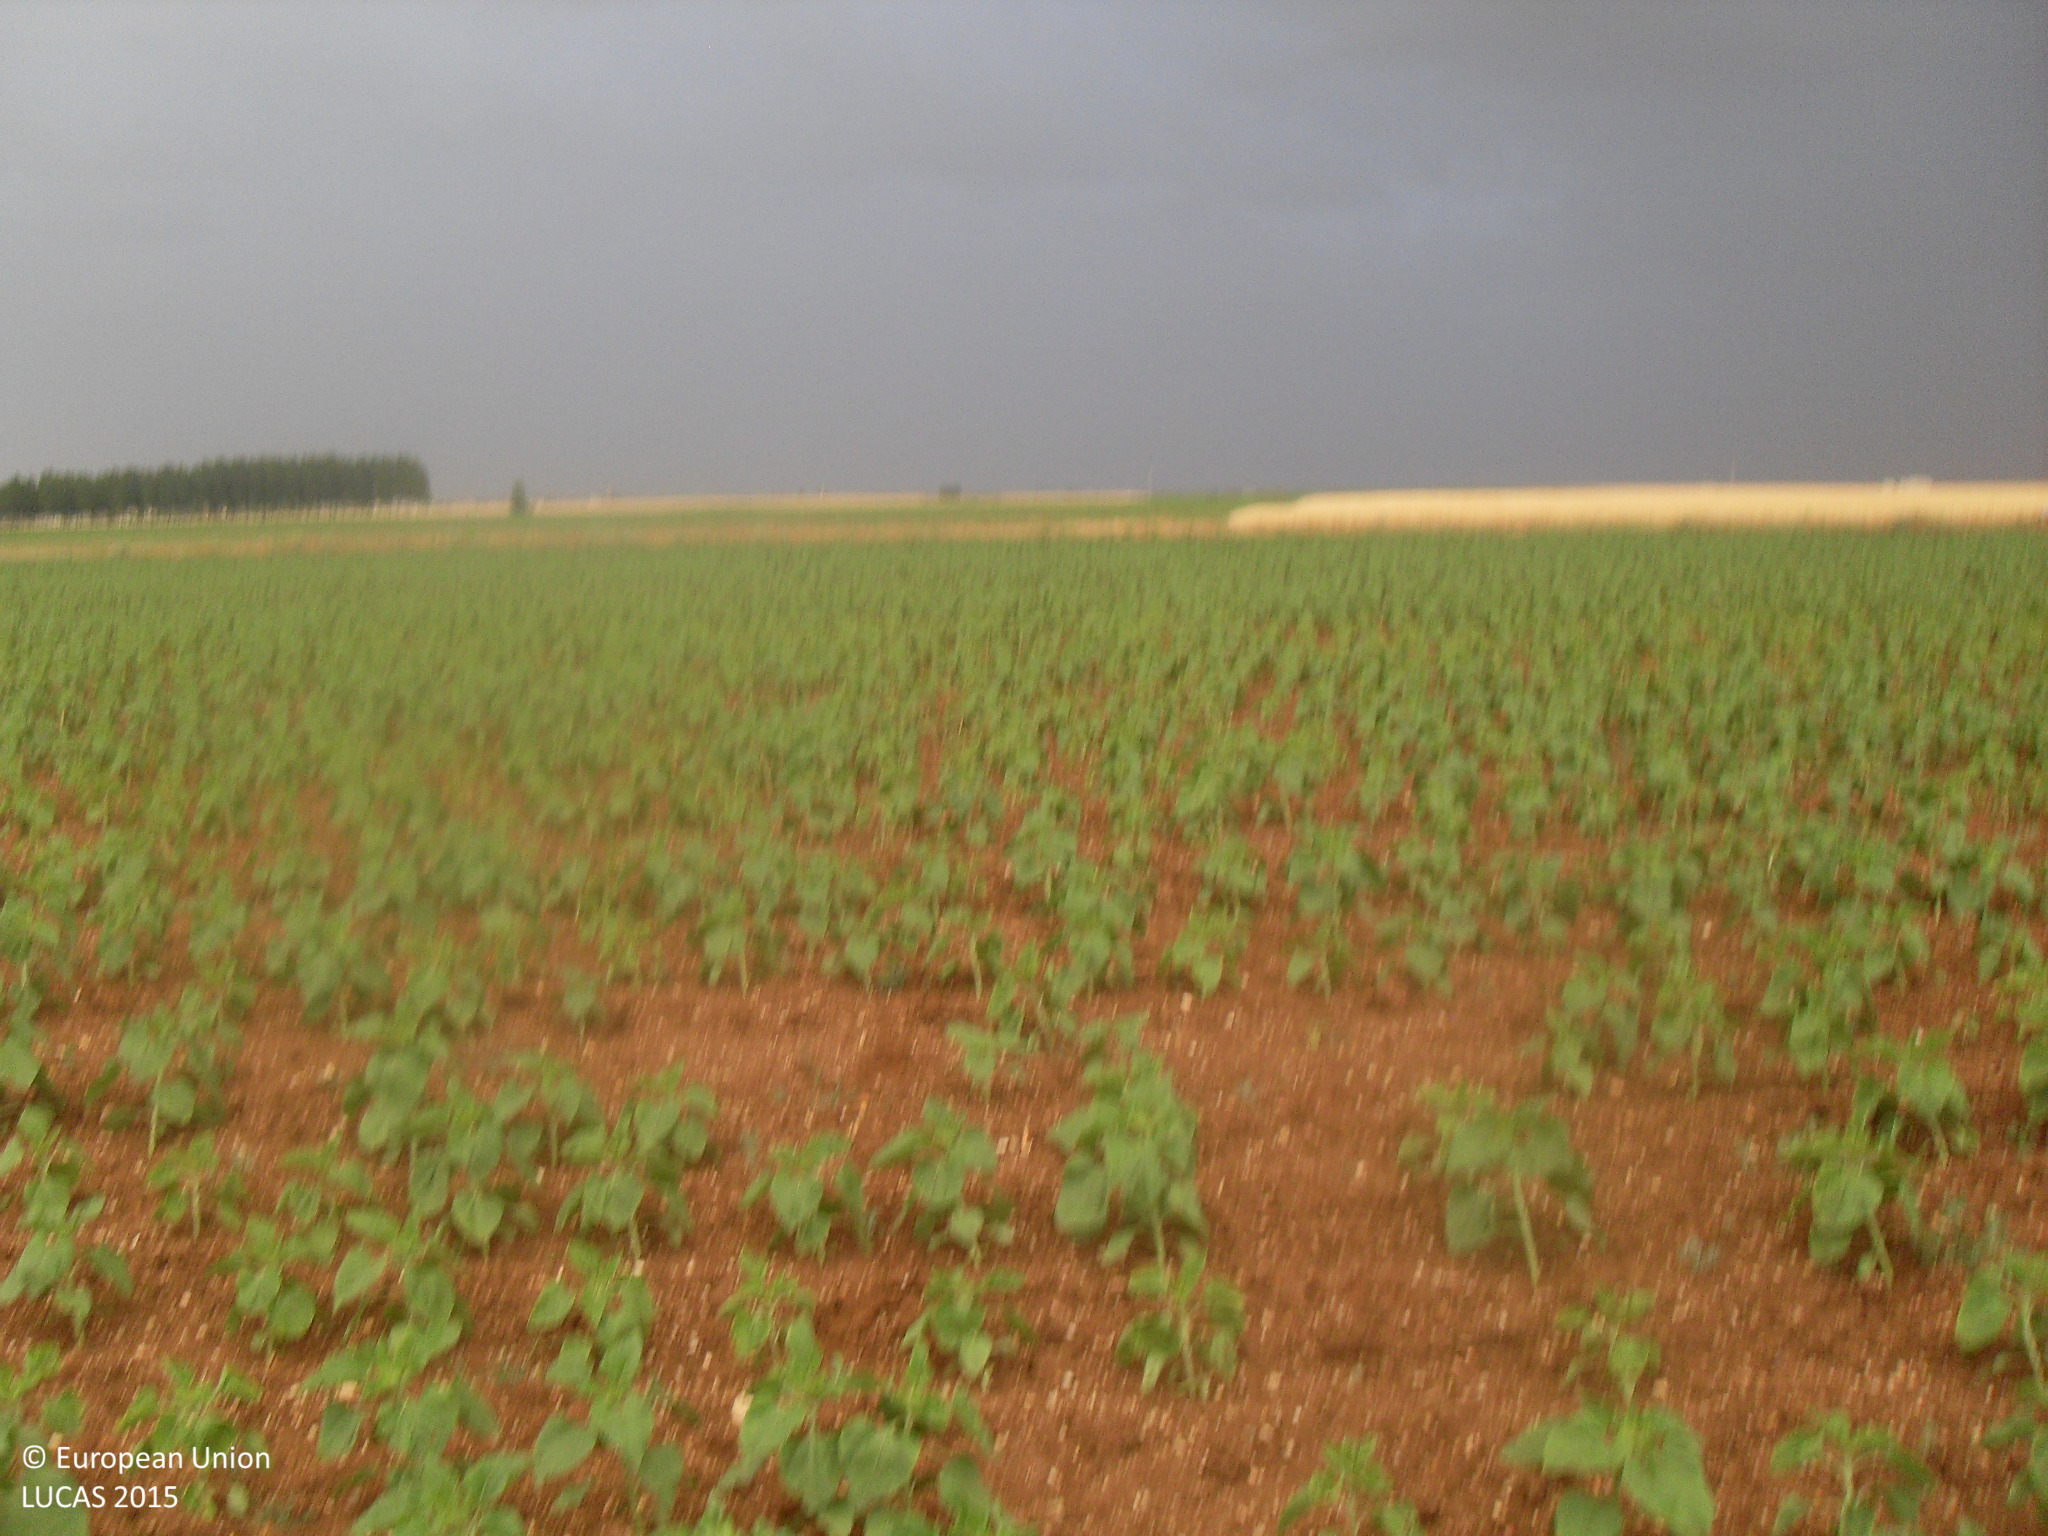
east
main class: Cropland
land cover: Sunflower
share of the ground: 25 - 50 %
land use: Agriculture (excluding fallow land and kitchen gardens)
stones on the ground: < 10 %
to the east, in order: Sunflower; Grass margins; Tracks; Grass margins; Sunflower
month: June
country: ES
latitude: 41.0847
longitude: -5.7338
